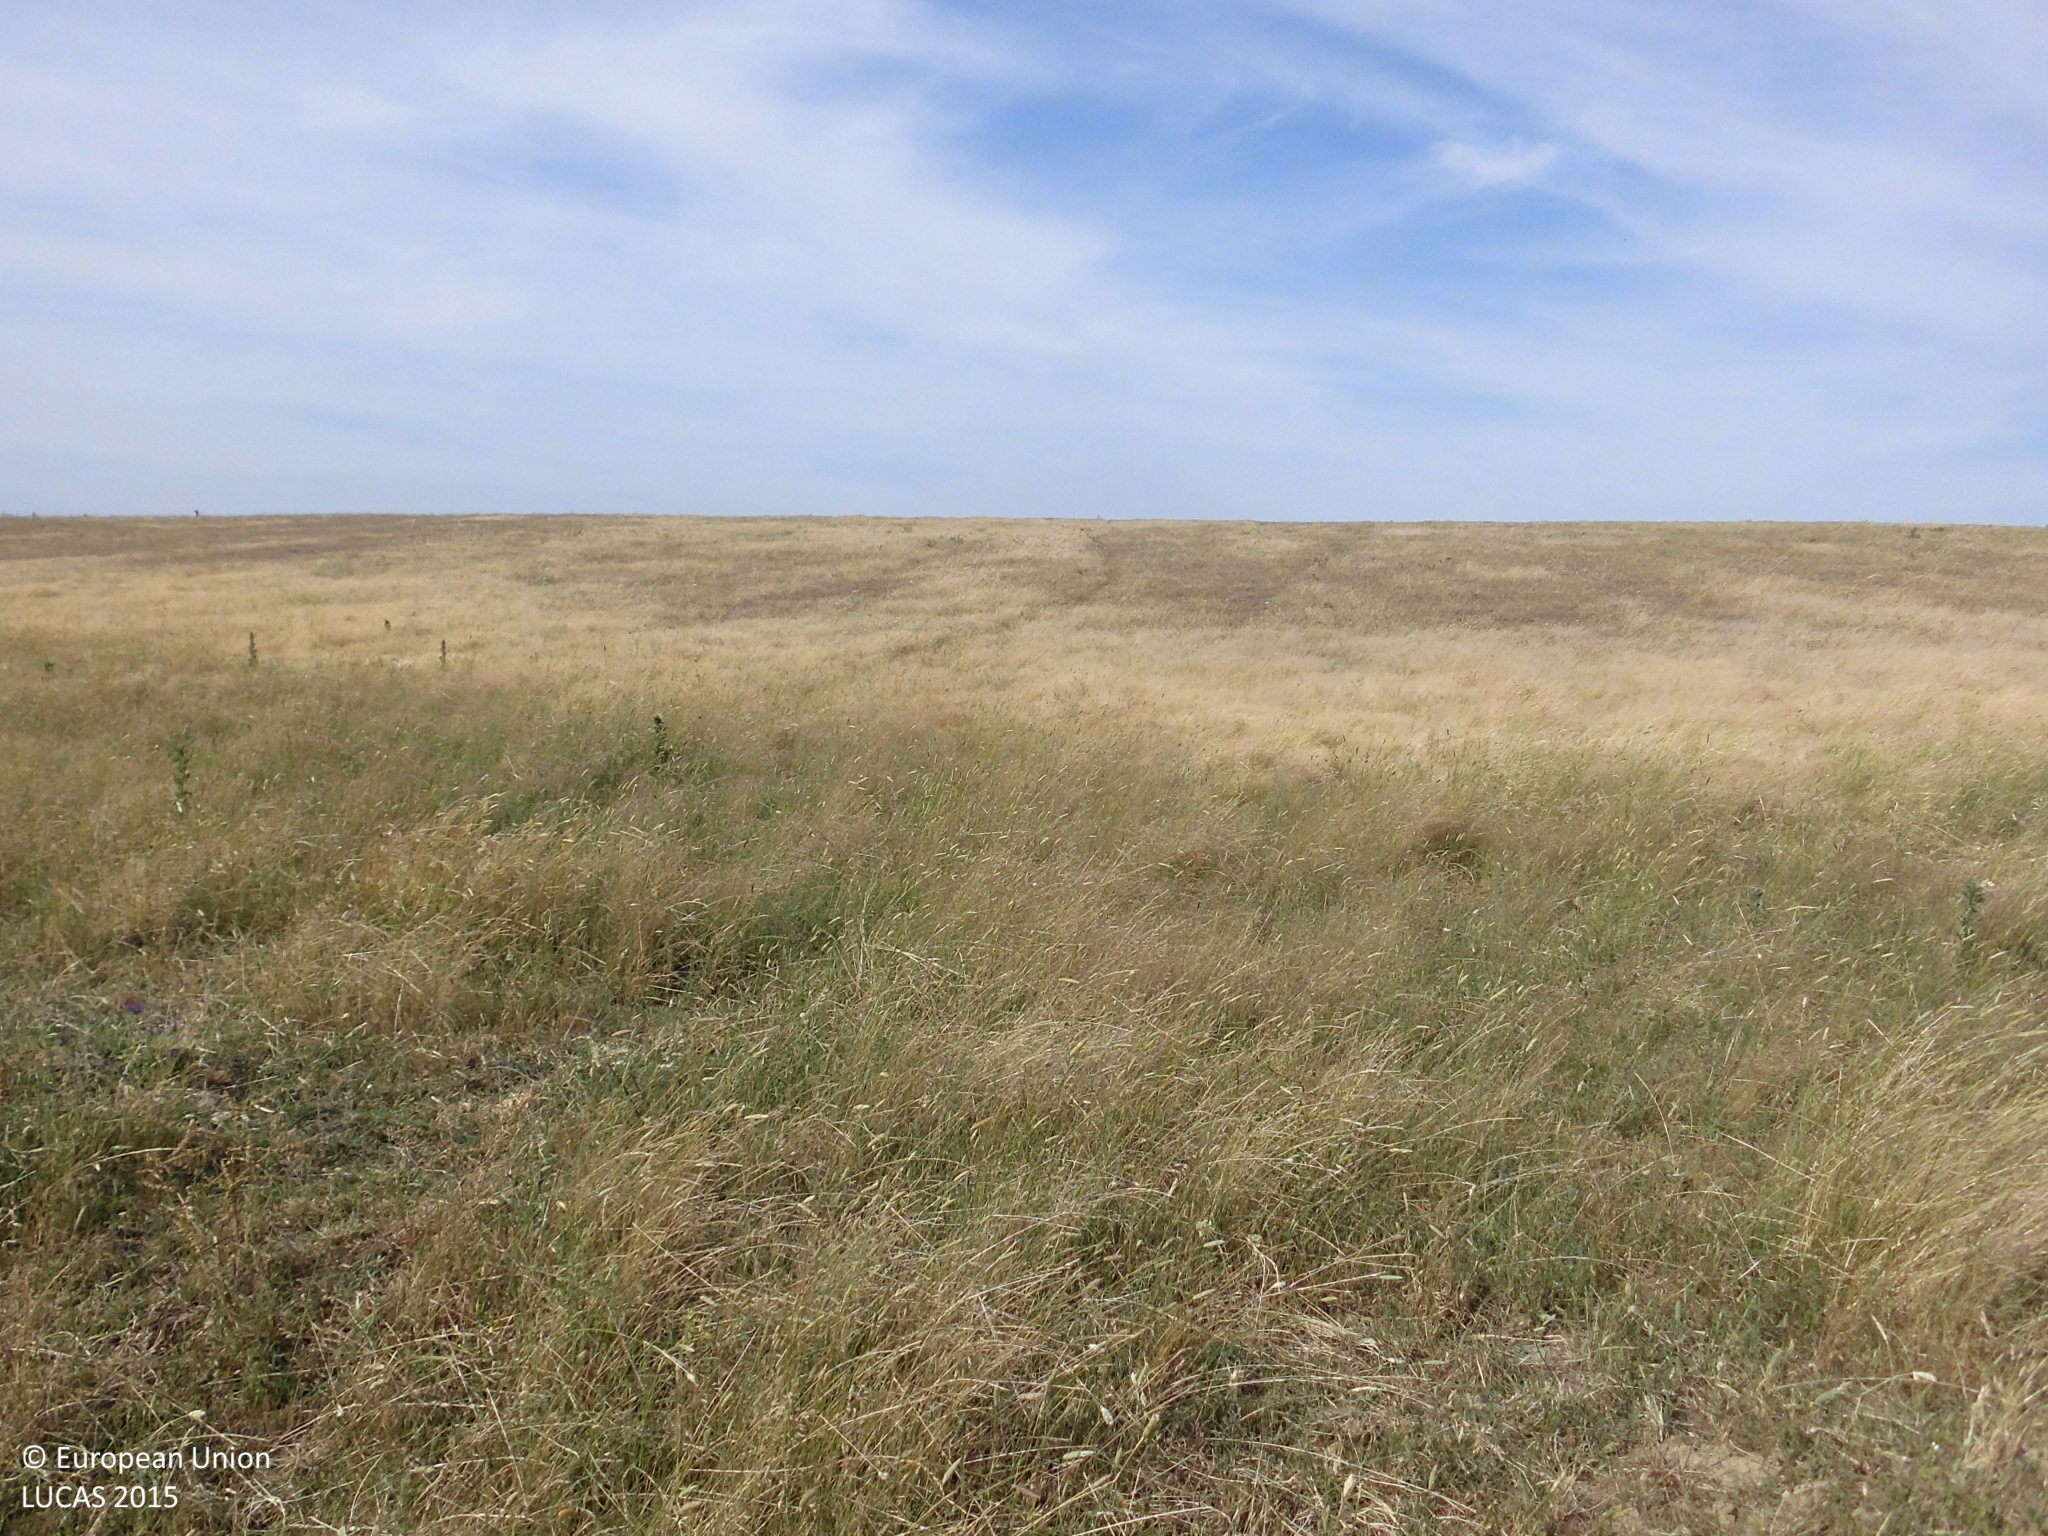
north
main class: Grassland
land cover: Spontaneously vegetated surfaces
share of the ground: > 75 %
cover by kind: herbaceous plants 100 %
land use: Agriculture (excluding fallow land and kitchen gardens)
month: May
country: ES
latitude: 39.4747
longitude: -6.0218
